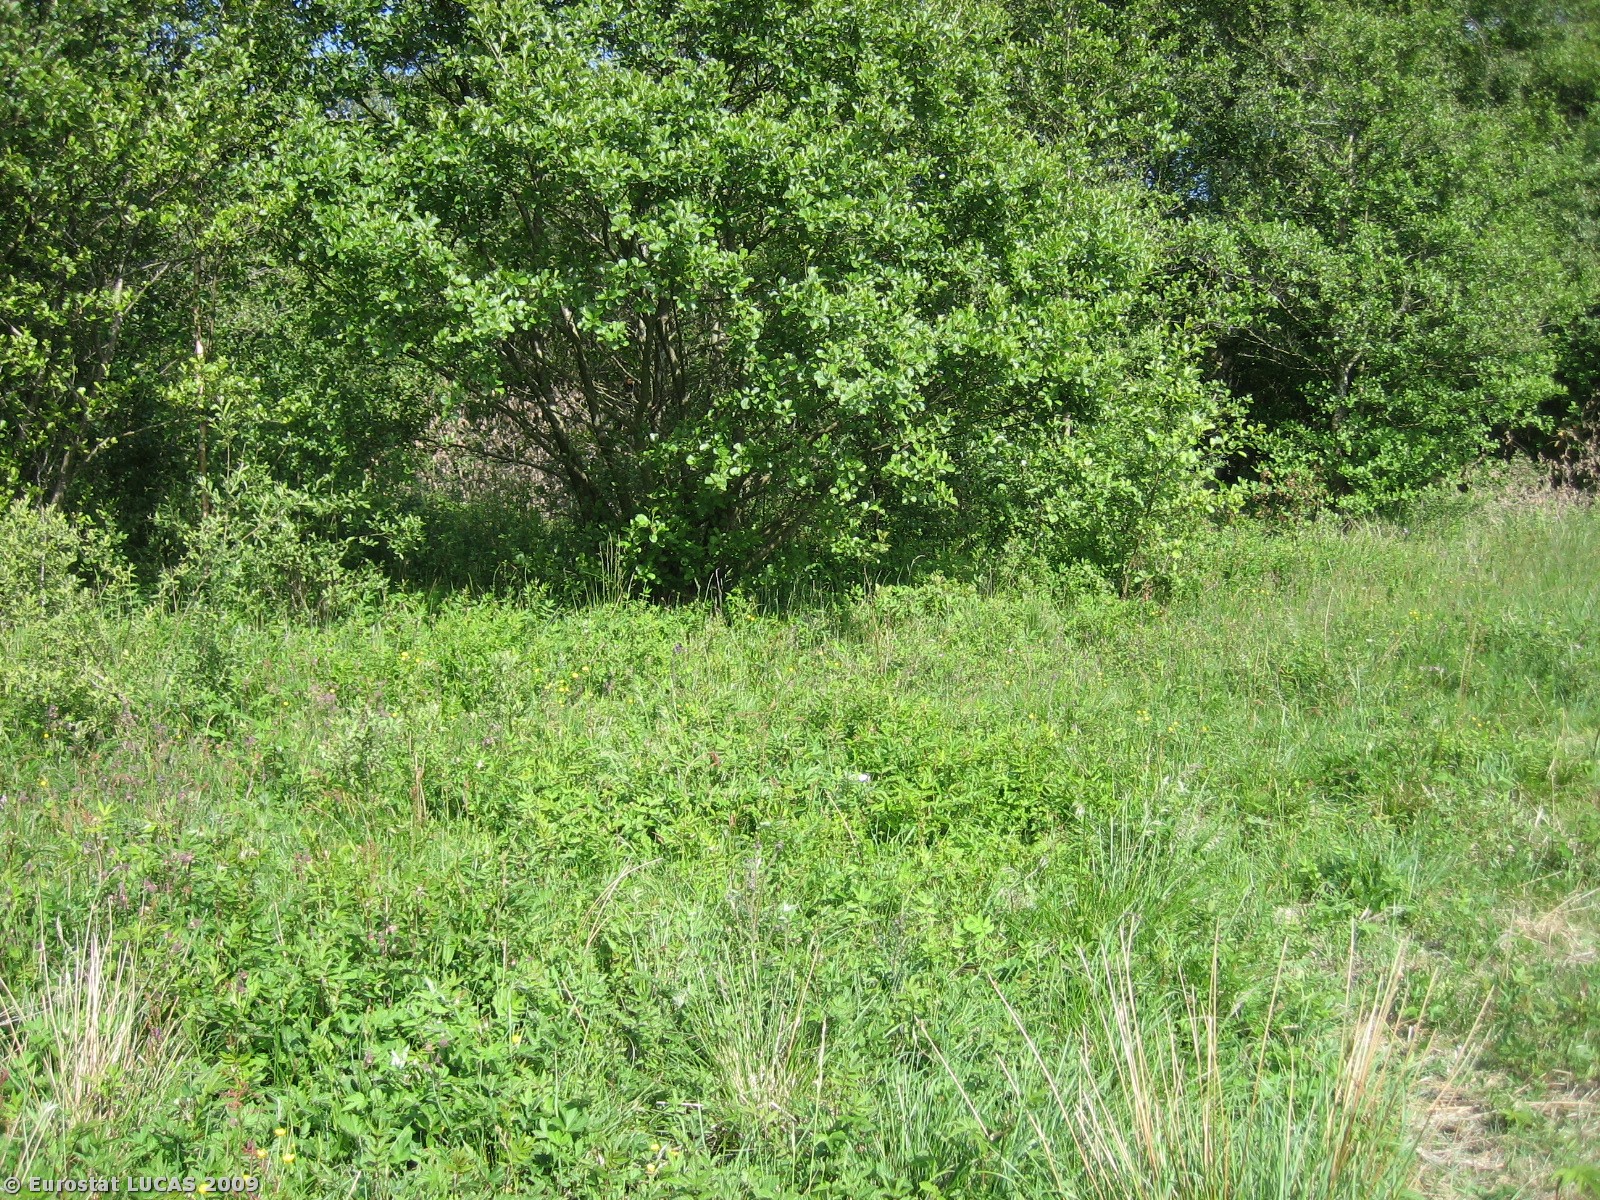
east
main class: Cropland
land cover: Barley
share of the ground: > 75 %
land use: Agriculture (excluding fallow land and kitchen gardens)
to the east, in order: Barley; Broadleaved woodland; Grassland without tree/shrub cover; Tracks; Grassland without tree/shrub cover; Grassland with sparse tree/shrub cover; Broadleaved woodland; Coniferous woodland; Grassland without tree/shrub cover; Coniferous woodland
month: June
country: DK
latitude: 56.0438
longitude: 9.8557
